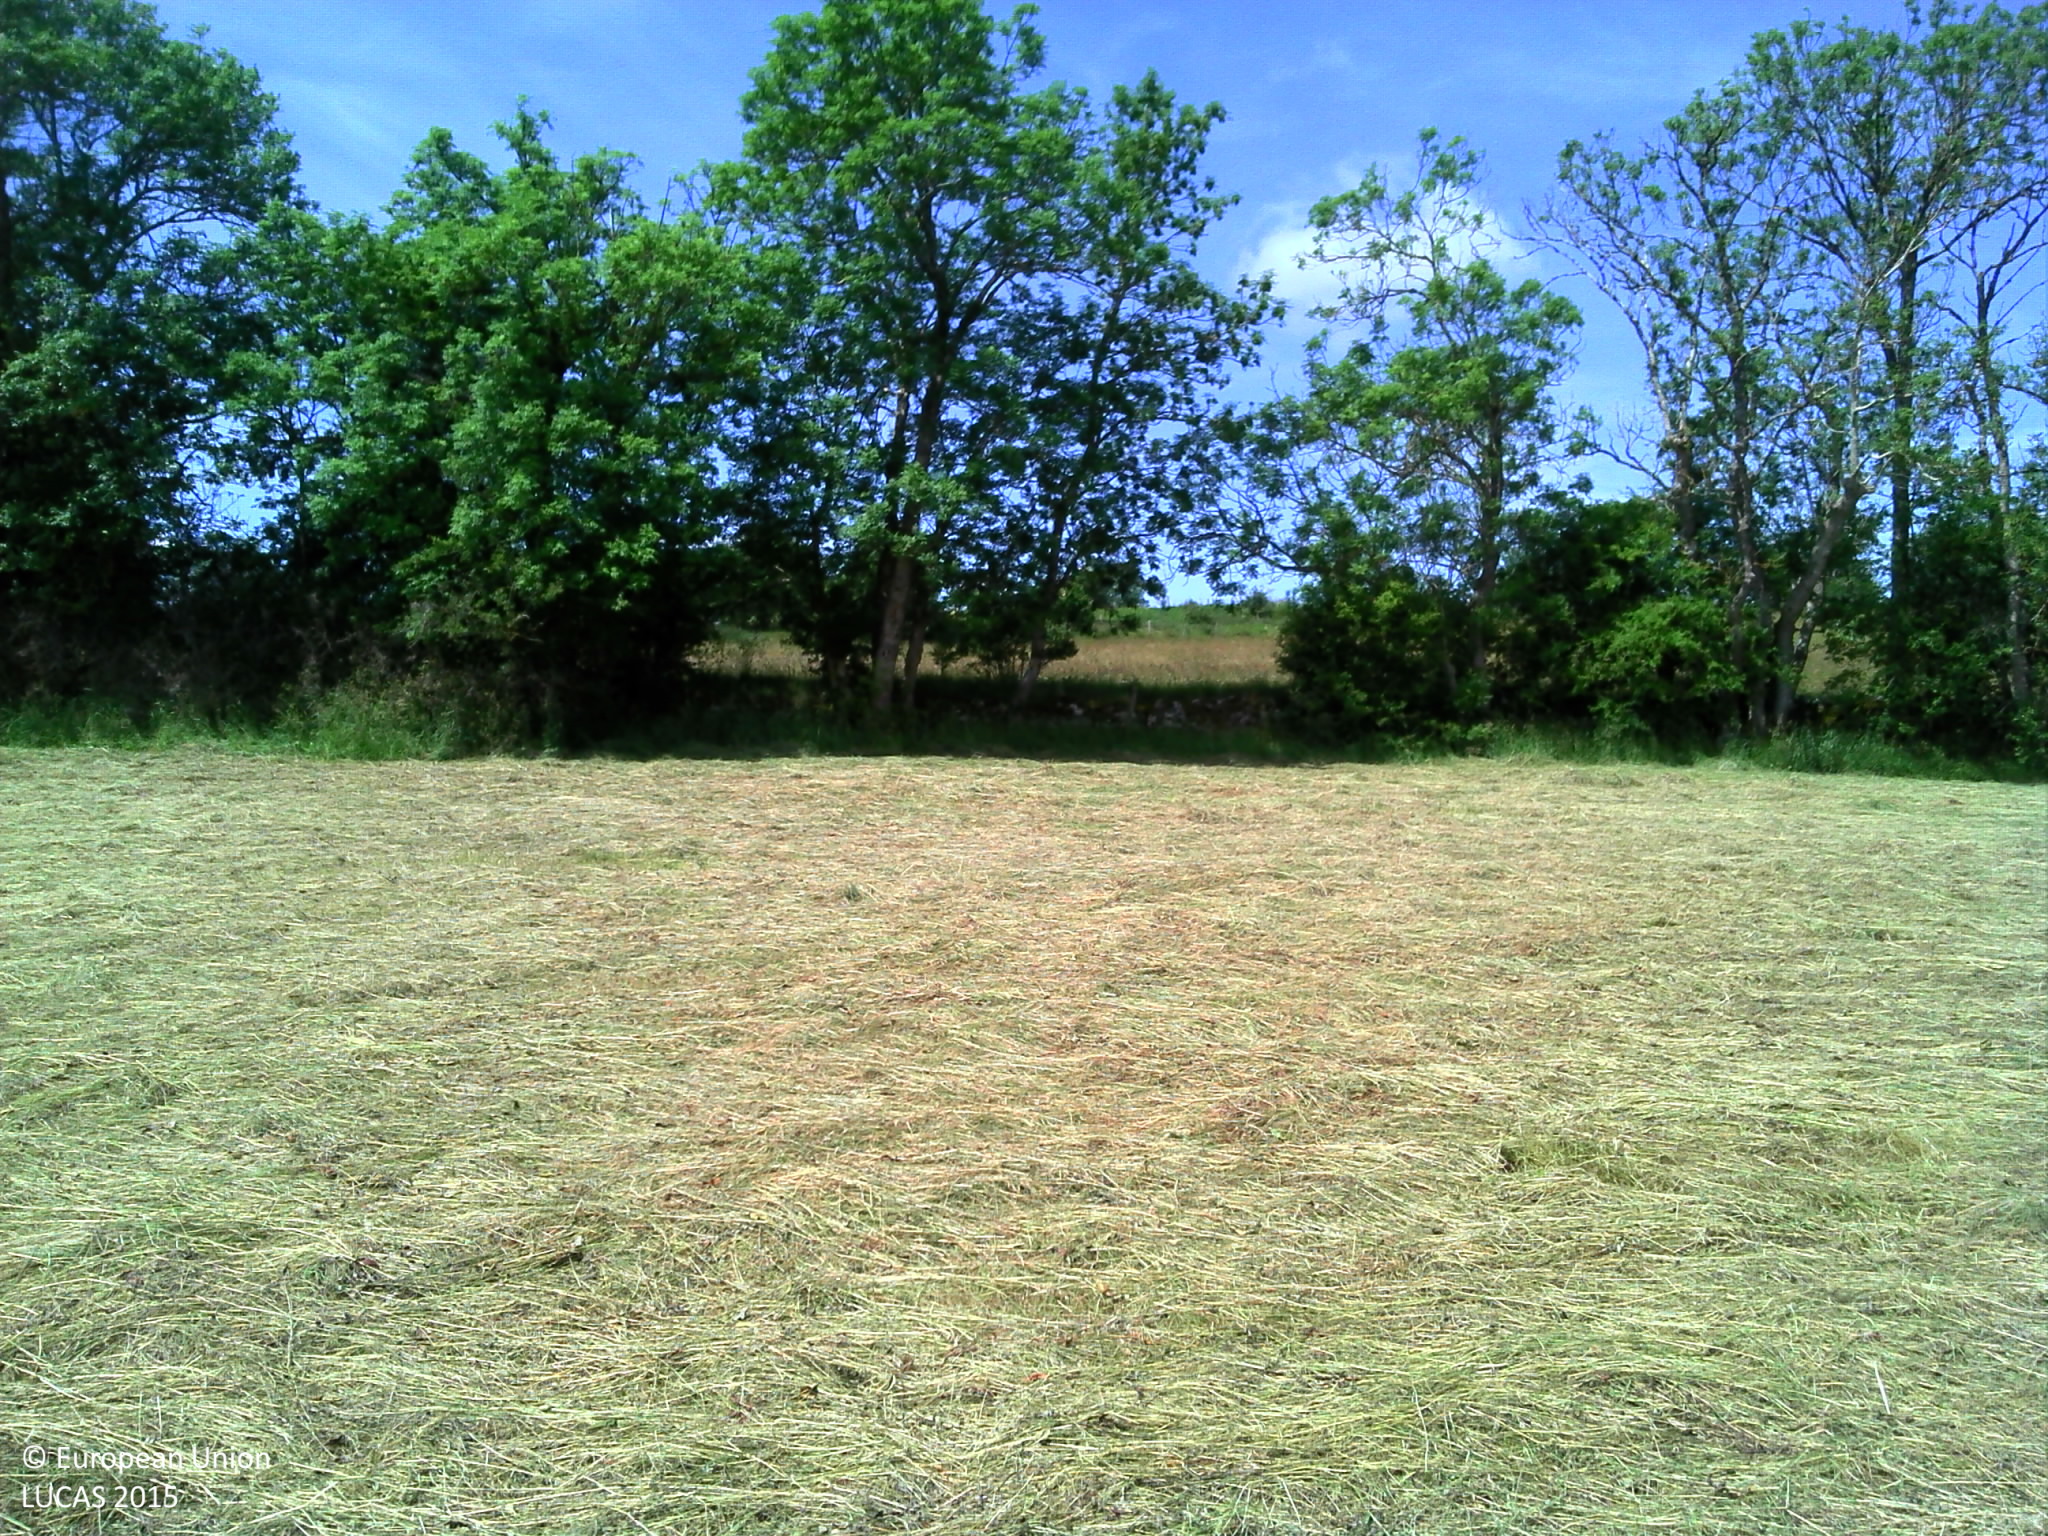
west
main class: Grassland
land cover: Grassland without tree/shrub cover
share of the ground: > 75 %
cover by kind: herbaceous plants 100 %
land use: Agriculture (excluding fallow land and kitchen gardens)
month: June
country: FR
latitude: 45.0143
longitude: 2.9341
